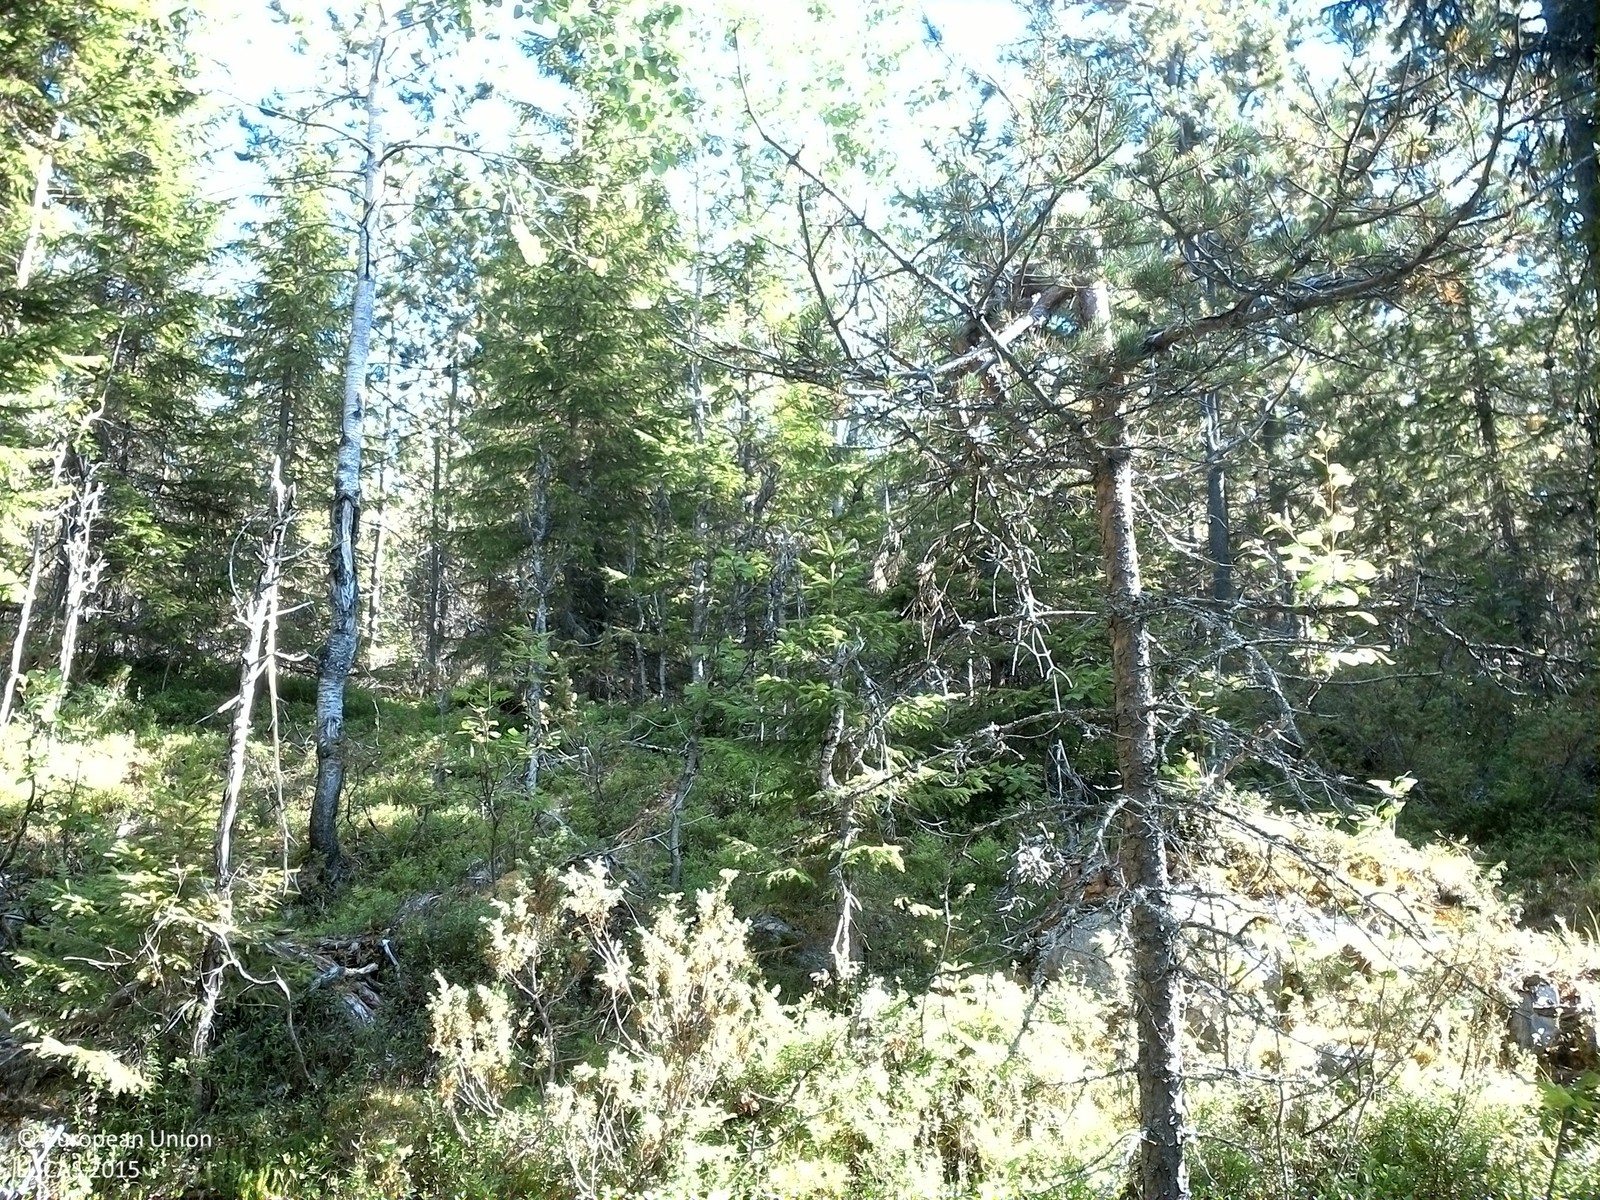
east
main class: Woodland
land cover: Pine dominated mixed woodland
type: boreal forest
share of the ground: 50 - 75 %
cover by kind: coniferous forest trees 35 %, shrubs 35 %, broadleaved forest trees 30 %
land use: Forestry
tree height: > 5 m
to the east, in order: Pine dominated mixed woodland; Pine dominated coniferous woodland
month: August
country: SE
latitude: 63.9068
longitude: 17.6131
